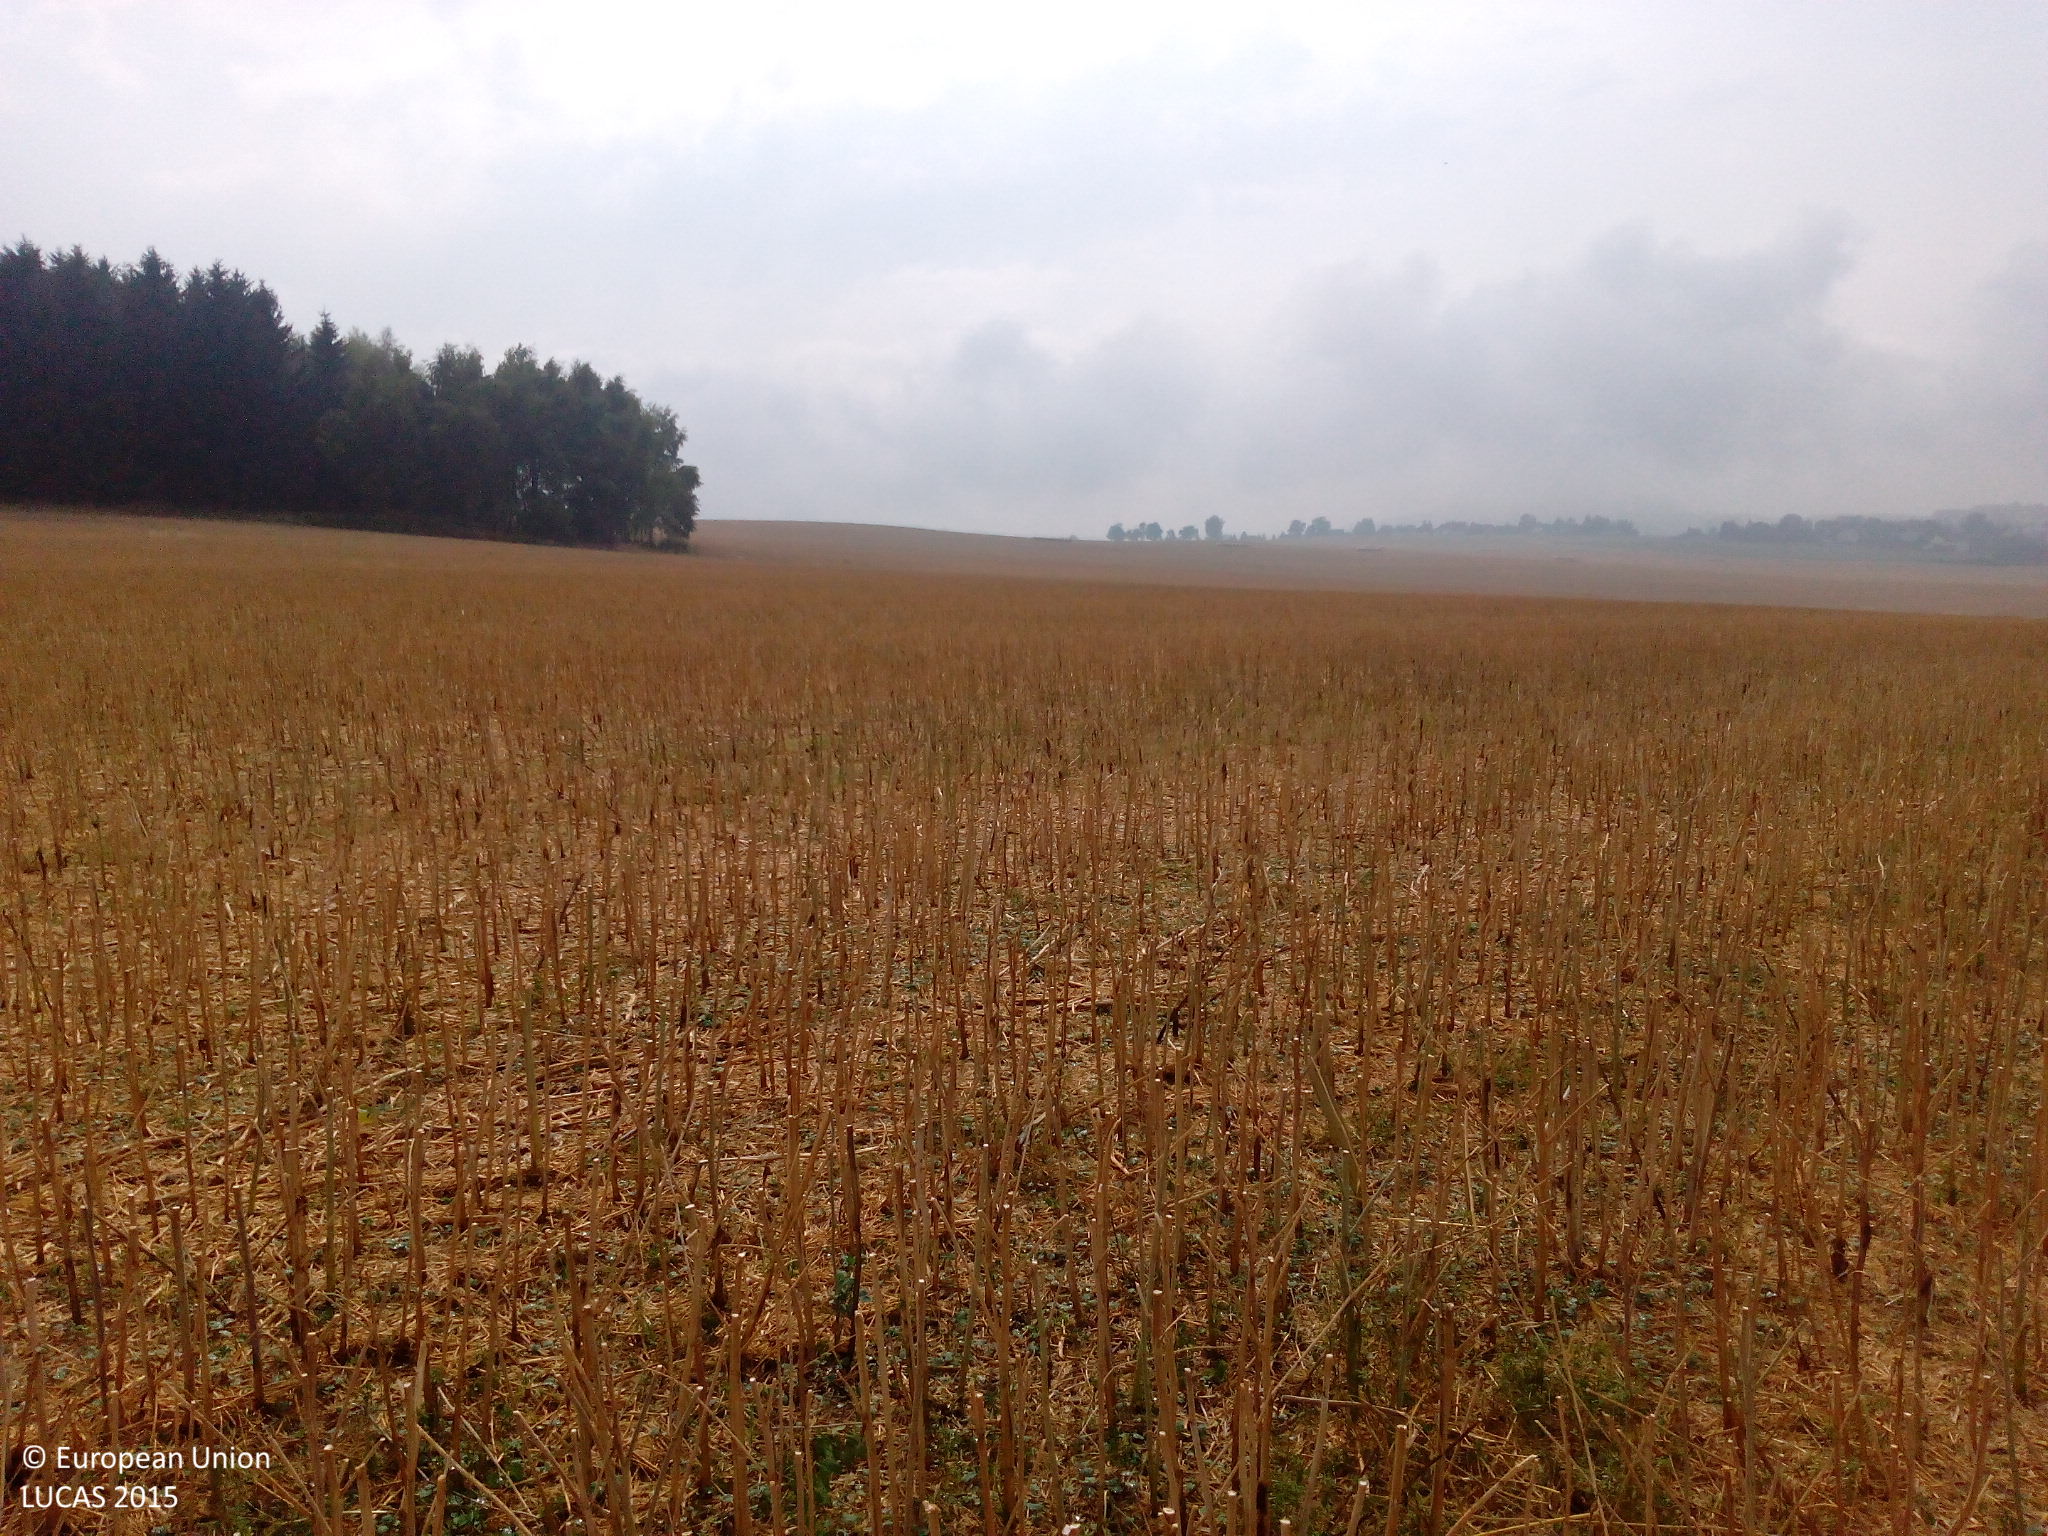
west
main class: Cropland
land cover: Rape and turnip rape
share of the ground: > 75 %
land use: Agriculture (excluding fallow land and kitchen gardens)
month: August
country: DE
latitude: 50.8143
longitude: 13.5061
